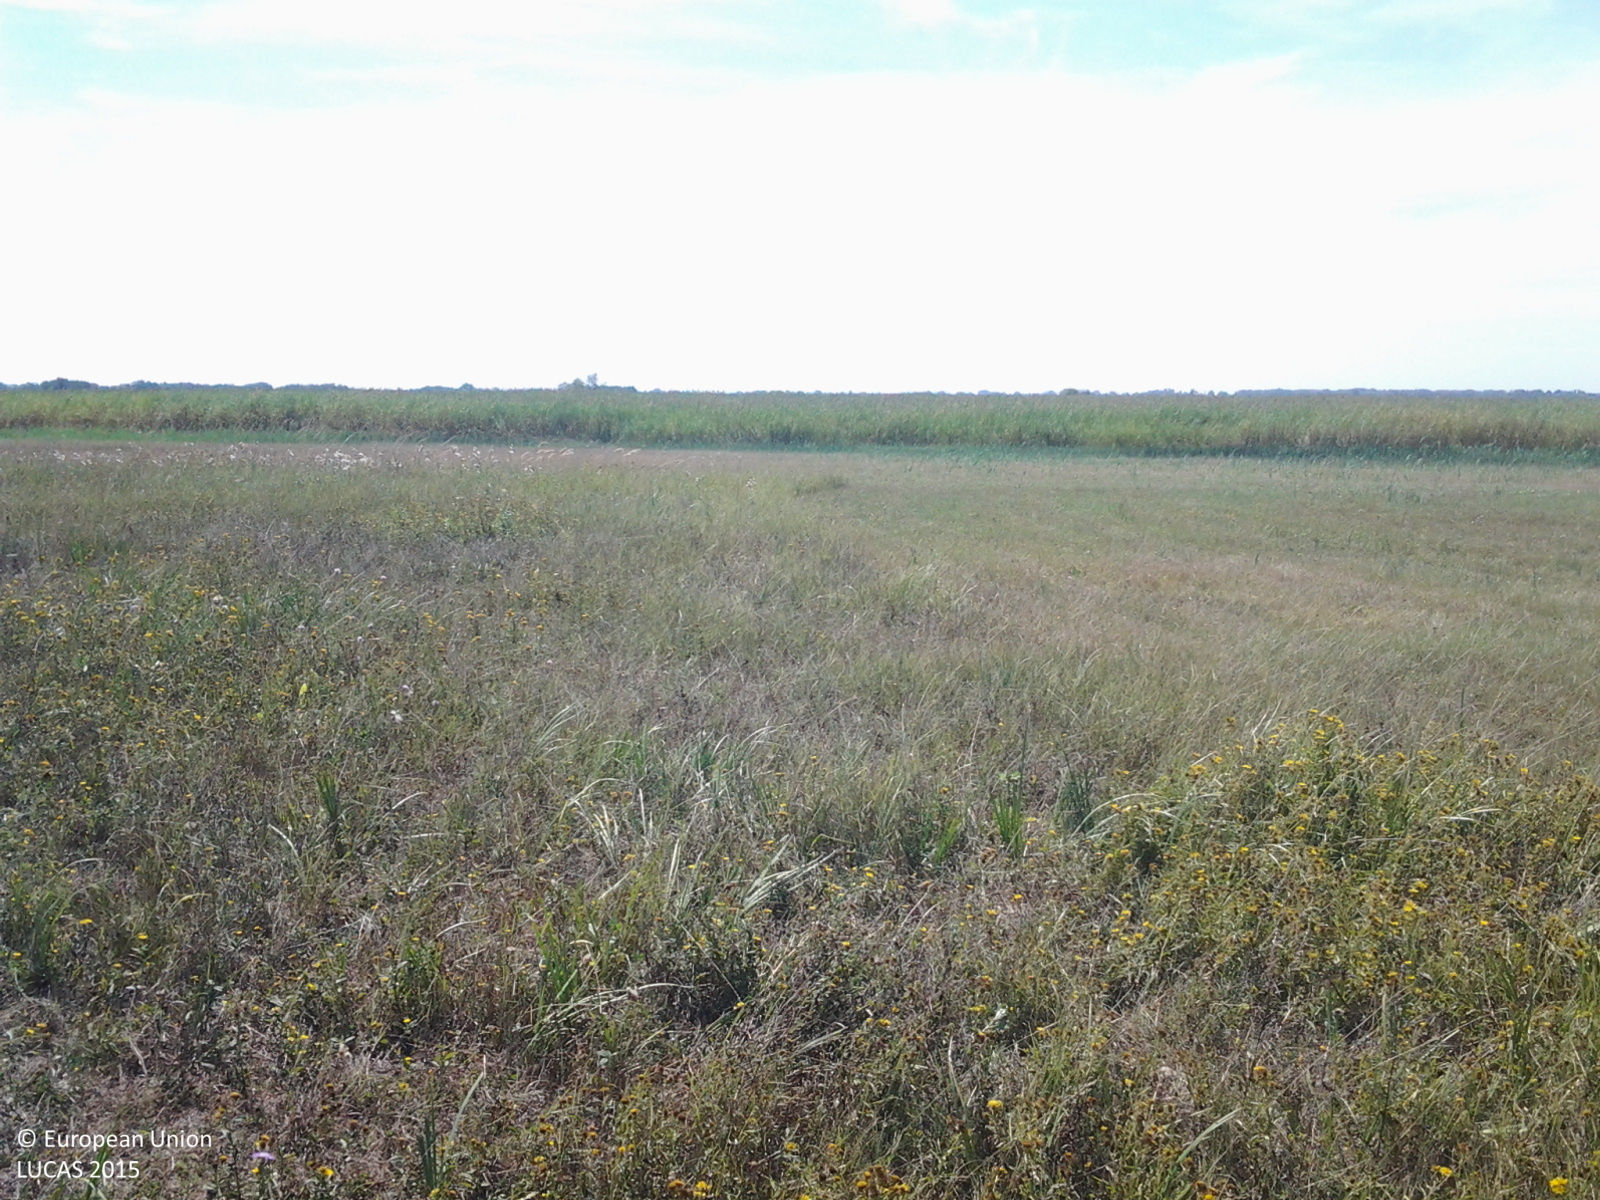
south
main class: Grassland
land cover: Grassland without tree/shrub cover
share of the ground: > 75 %
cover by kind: herbaceous plants 100 %
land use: Agriculture (excluding fallow land and kitchen gardens)
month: August
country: HU
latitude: 47.4038
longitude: 19.8164
